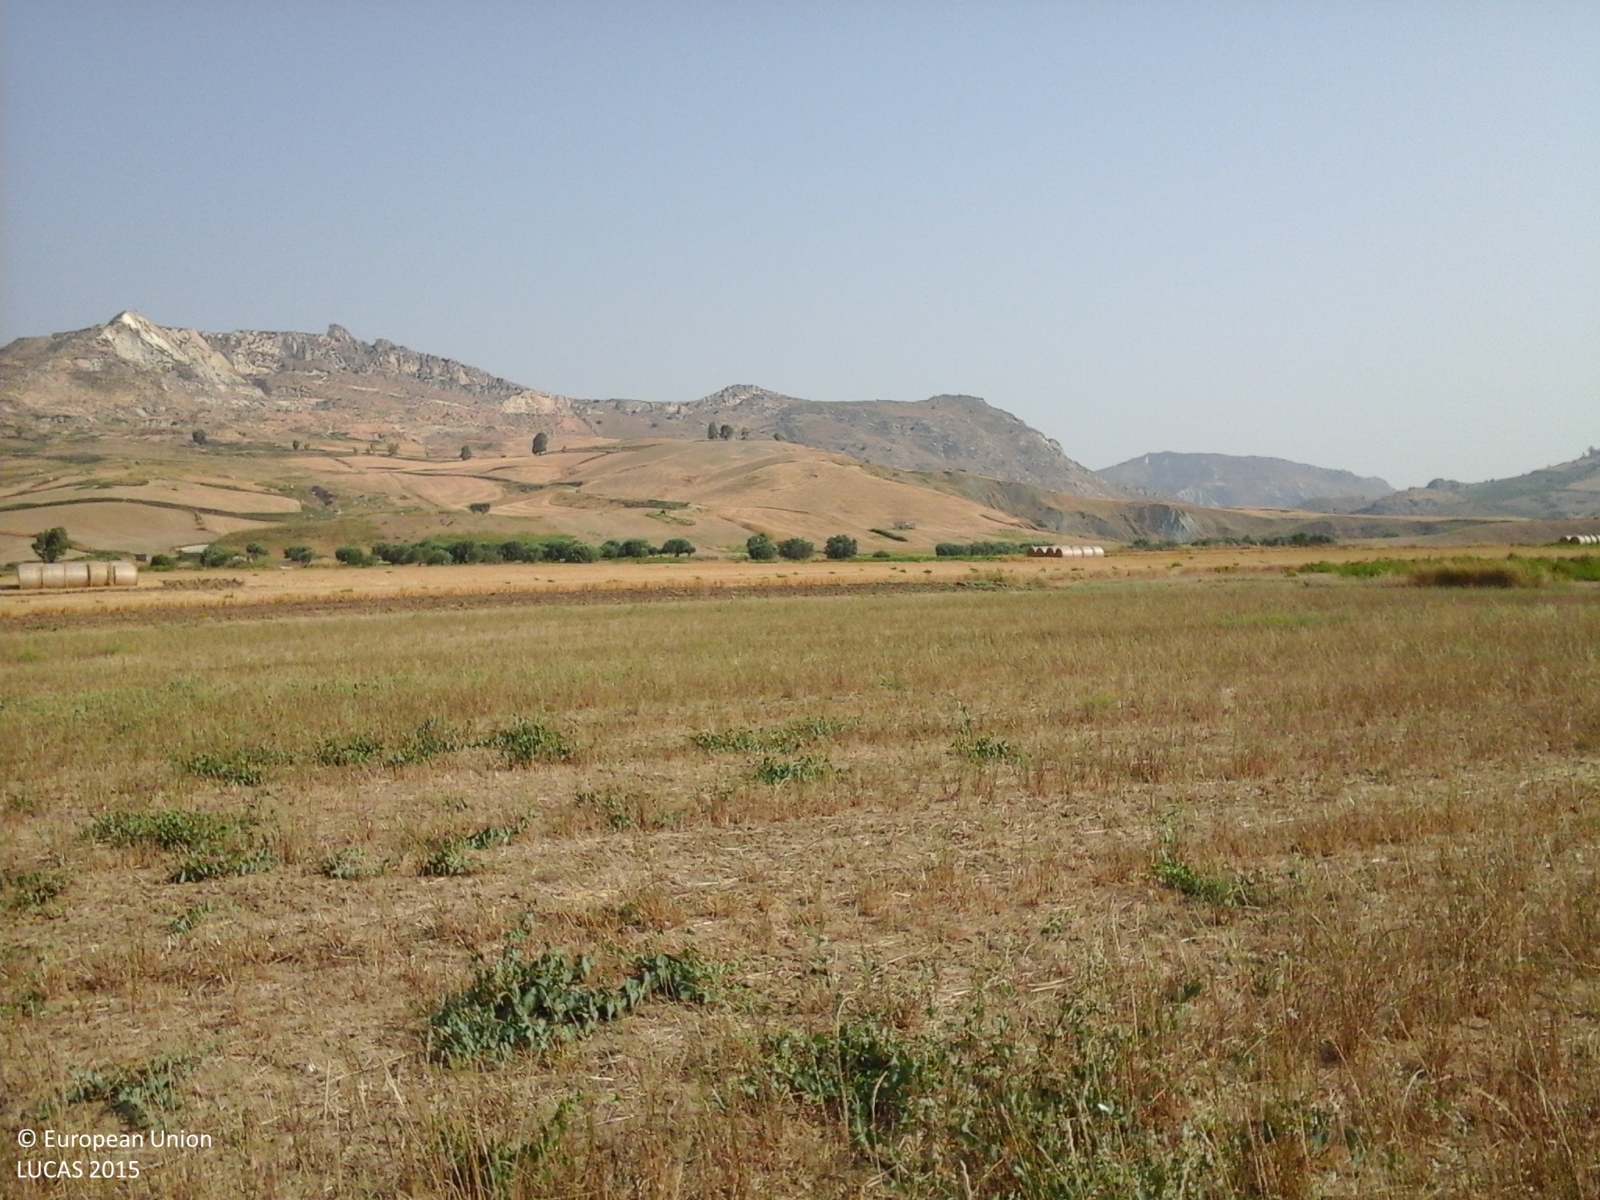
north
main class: Cropland
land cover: Durum wheat
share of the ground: > 75 %
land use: Agriculture (excluding fallow land and kitchen gardens)
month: July
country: IT
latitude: 37.1912
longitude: 13.9904
